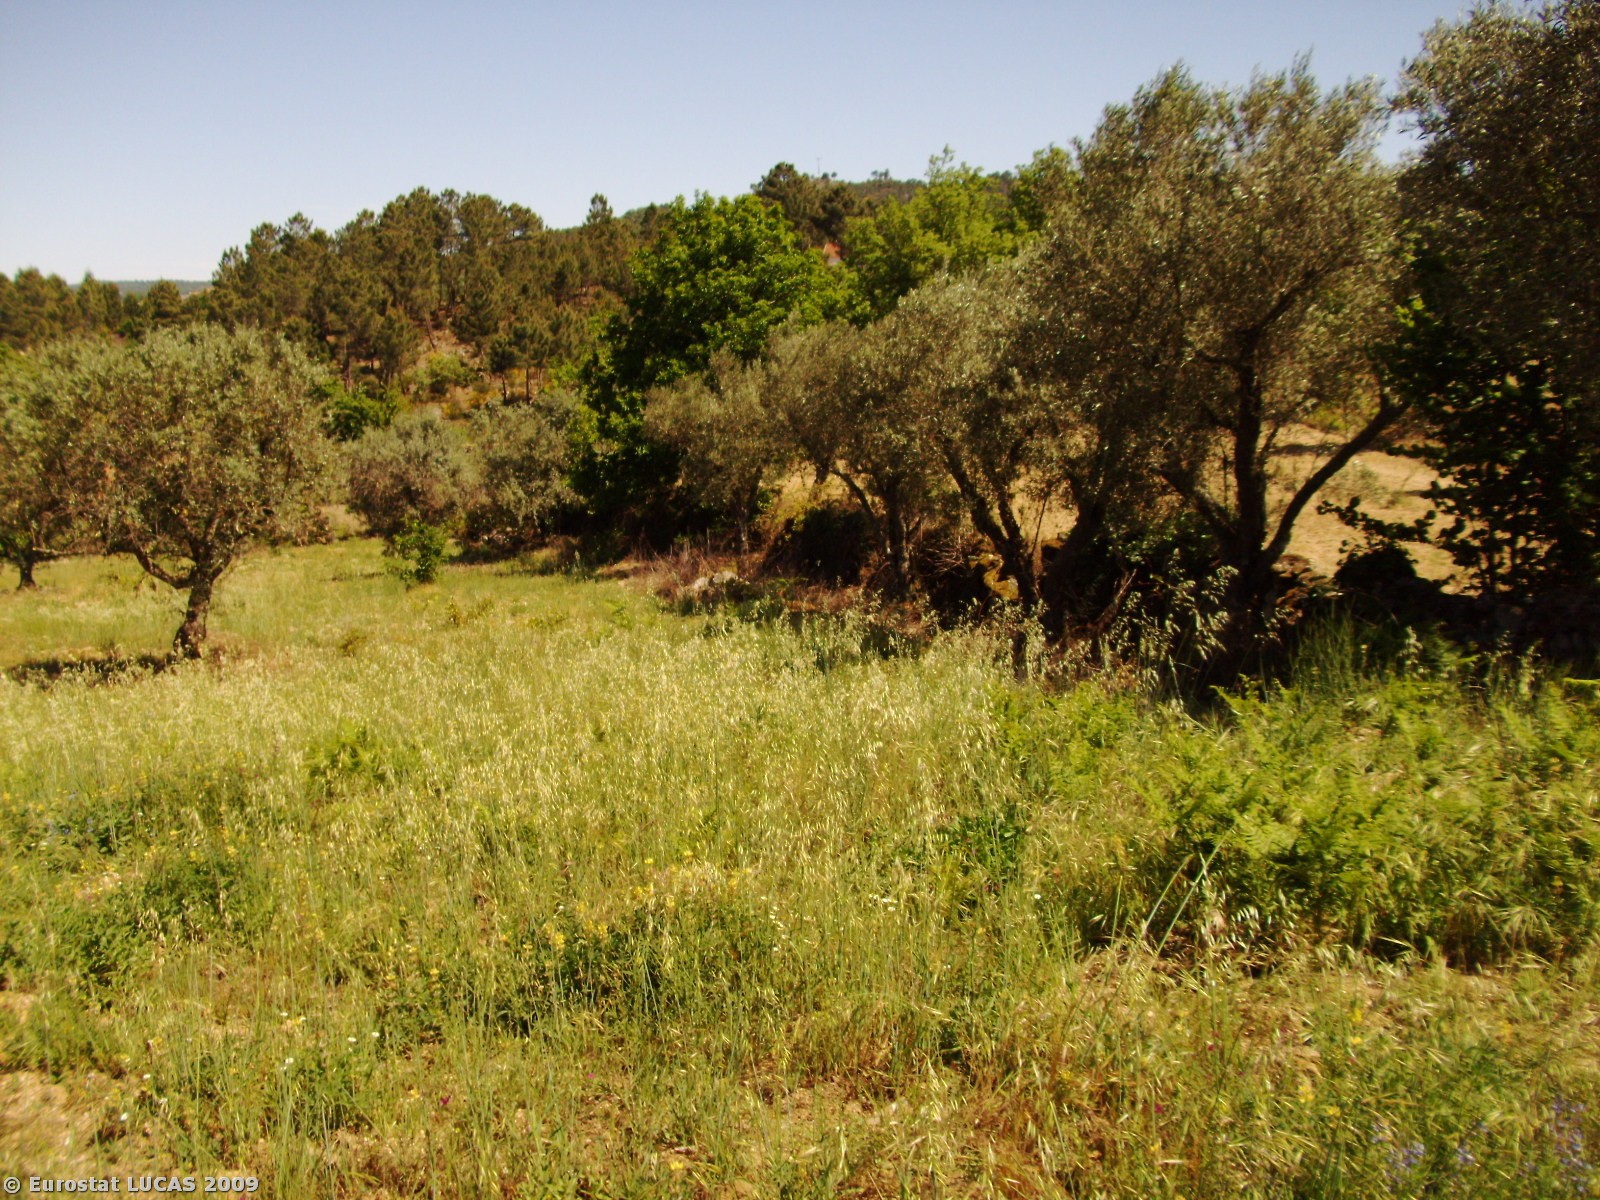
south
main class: Cropland
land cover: Olive groves
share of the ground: 50 - 75 %
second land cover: Spontaneously vegetated surfaces
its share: 25 - 50 %
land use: Agriculture (excluding fallow land and kitchen gardens)
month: May
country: PT
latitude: 40.9249
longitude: -7.5397
